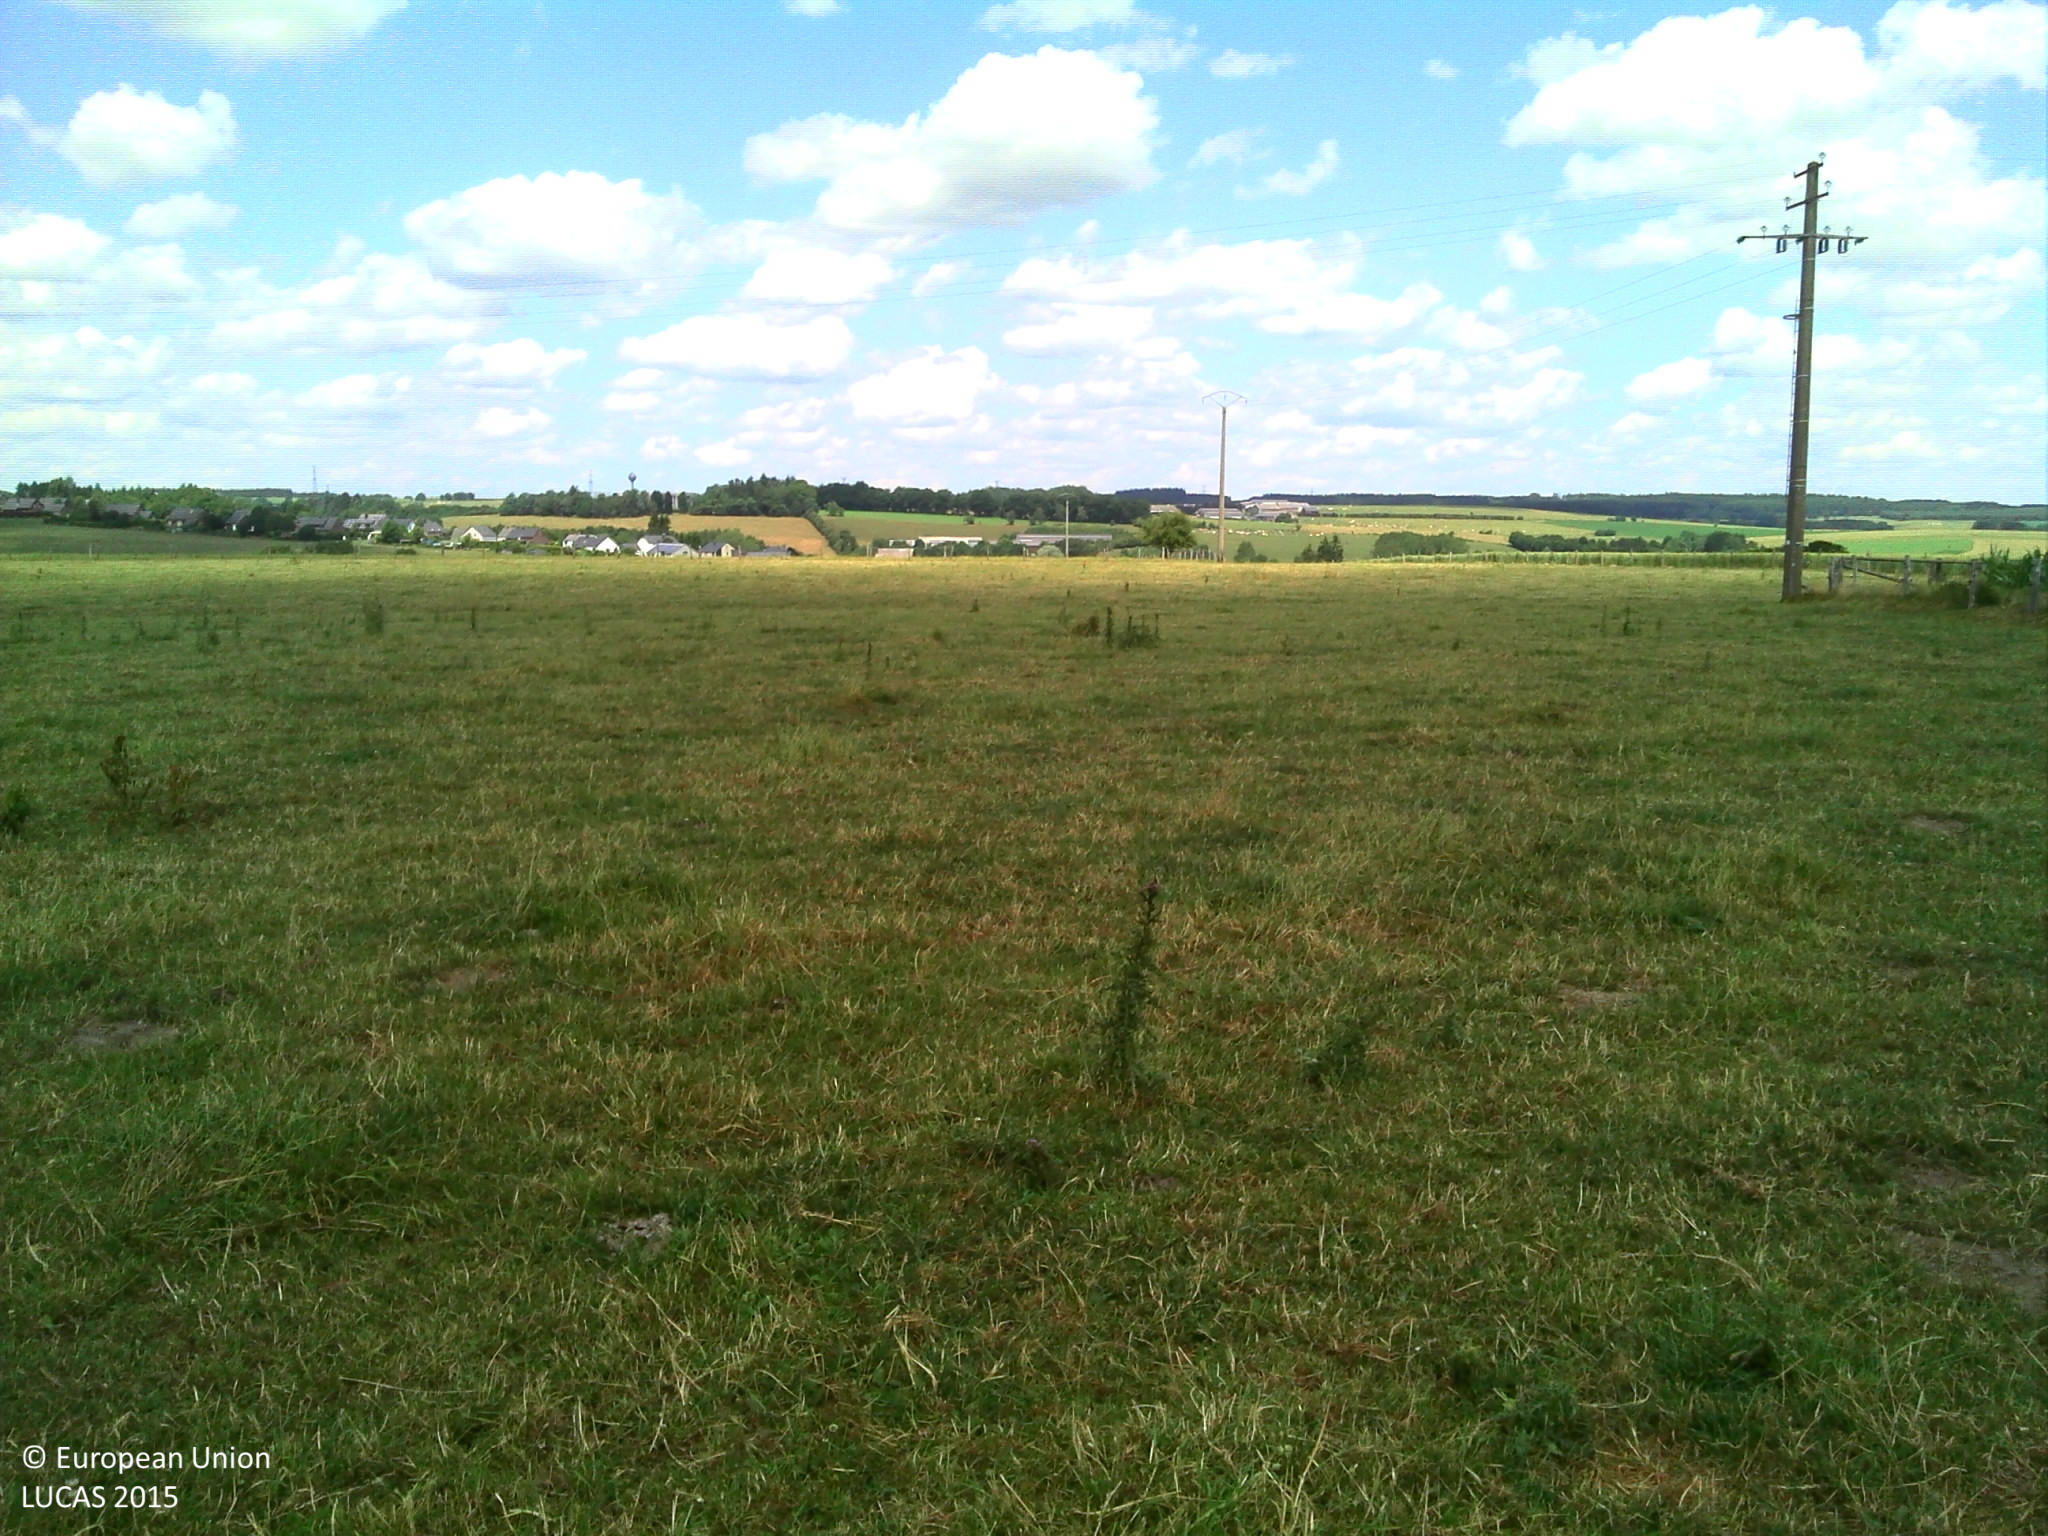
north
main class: Grassland
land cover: Grassland without tree/shrub cover
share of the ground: > 75 %
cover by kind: herbaceous plants 100 %
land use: Agriculture (excluding fallow land and kitchen gardens)
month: July
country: BE
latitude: 49.9968
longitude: 5.7439
